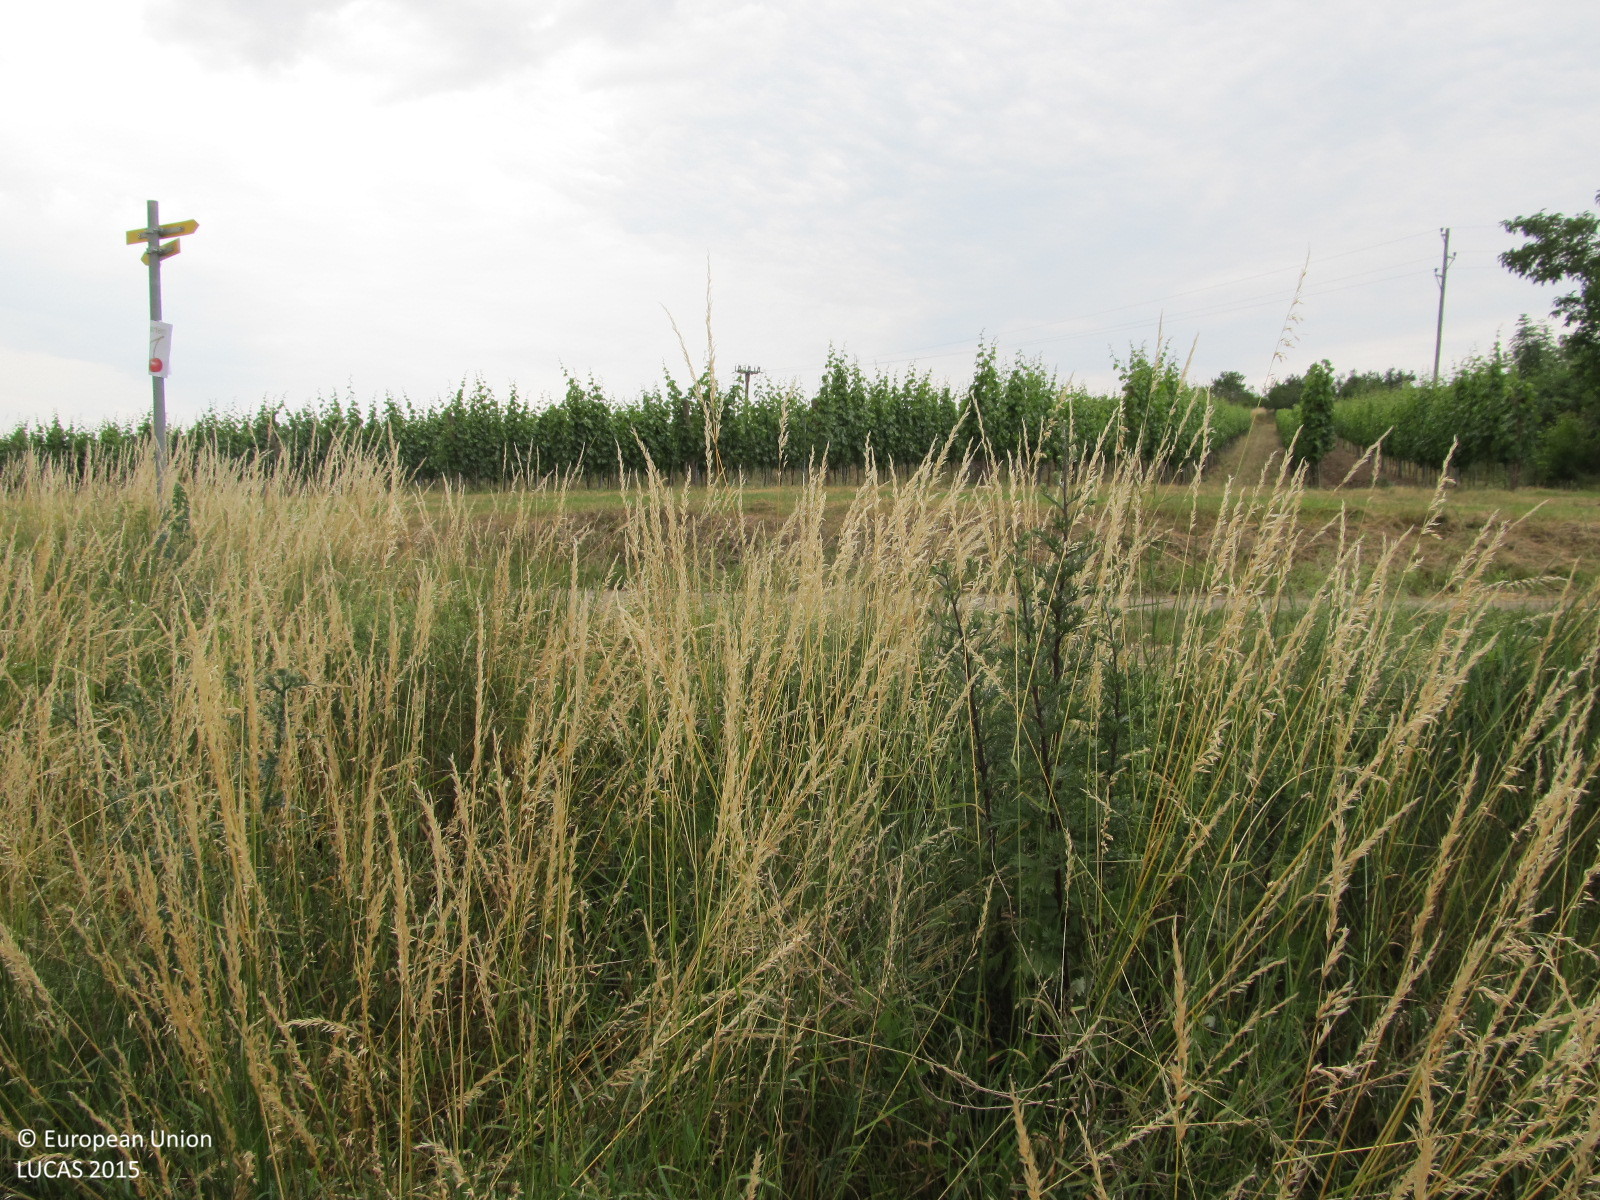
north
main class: Cropland
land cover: Durum wheat
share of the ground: > 75 %
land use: Agriculture (excluding fallow land and kitchen gardens)
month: June
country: AT
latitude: 48.7141
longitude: 15.9164
